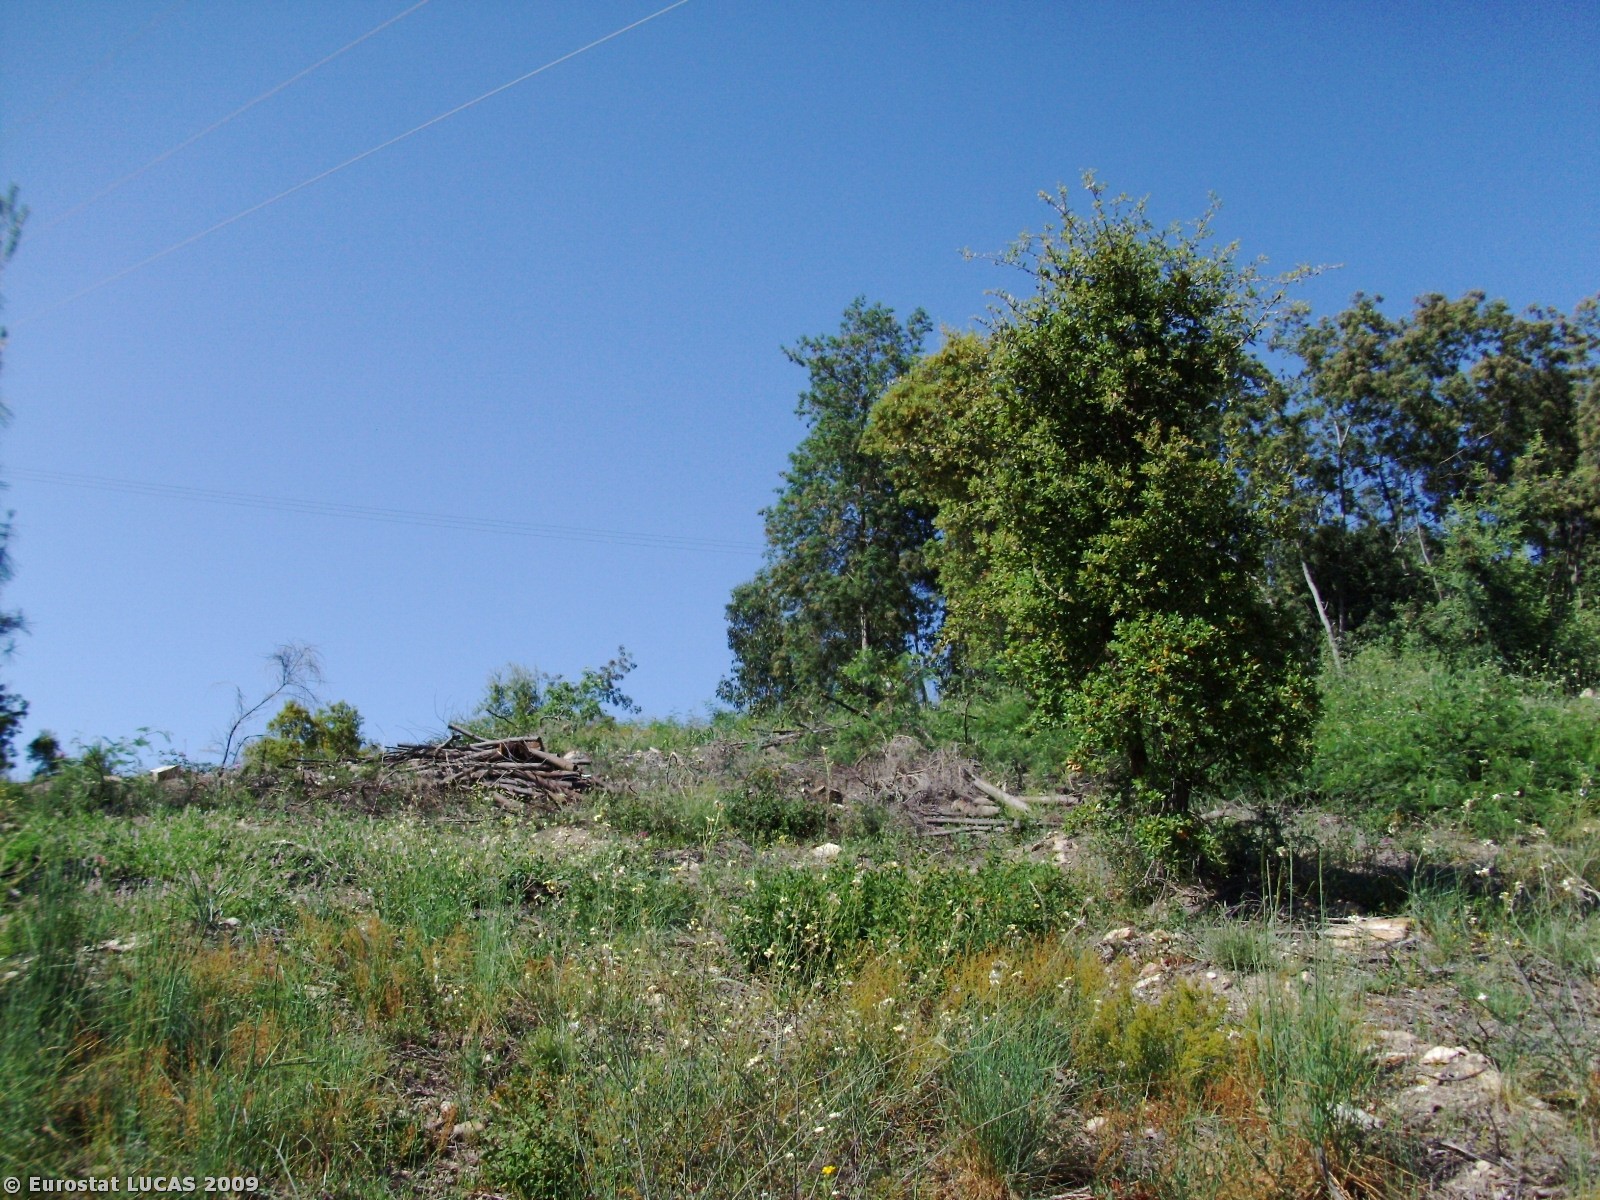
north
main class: Grassland
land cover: Grassland with sparse tree/shrub cover
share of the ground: 50 - 75 %
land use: Forestry
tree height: > 5 m
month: May
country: PT
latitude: 39.3036
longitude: -7.4245
